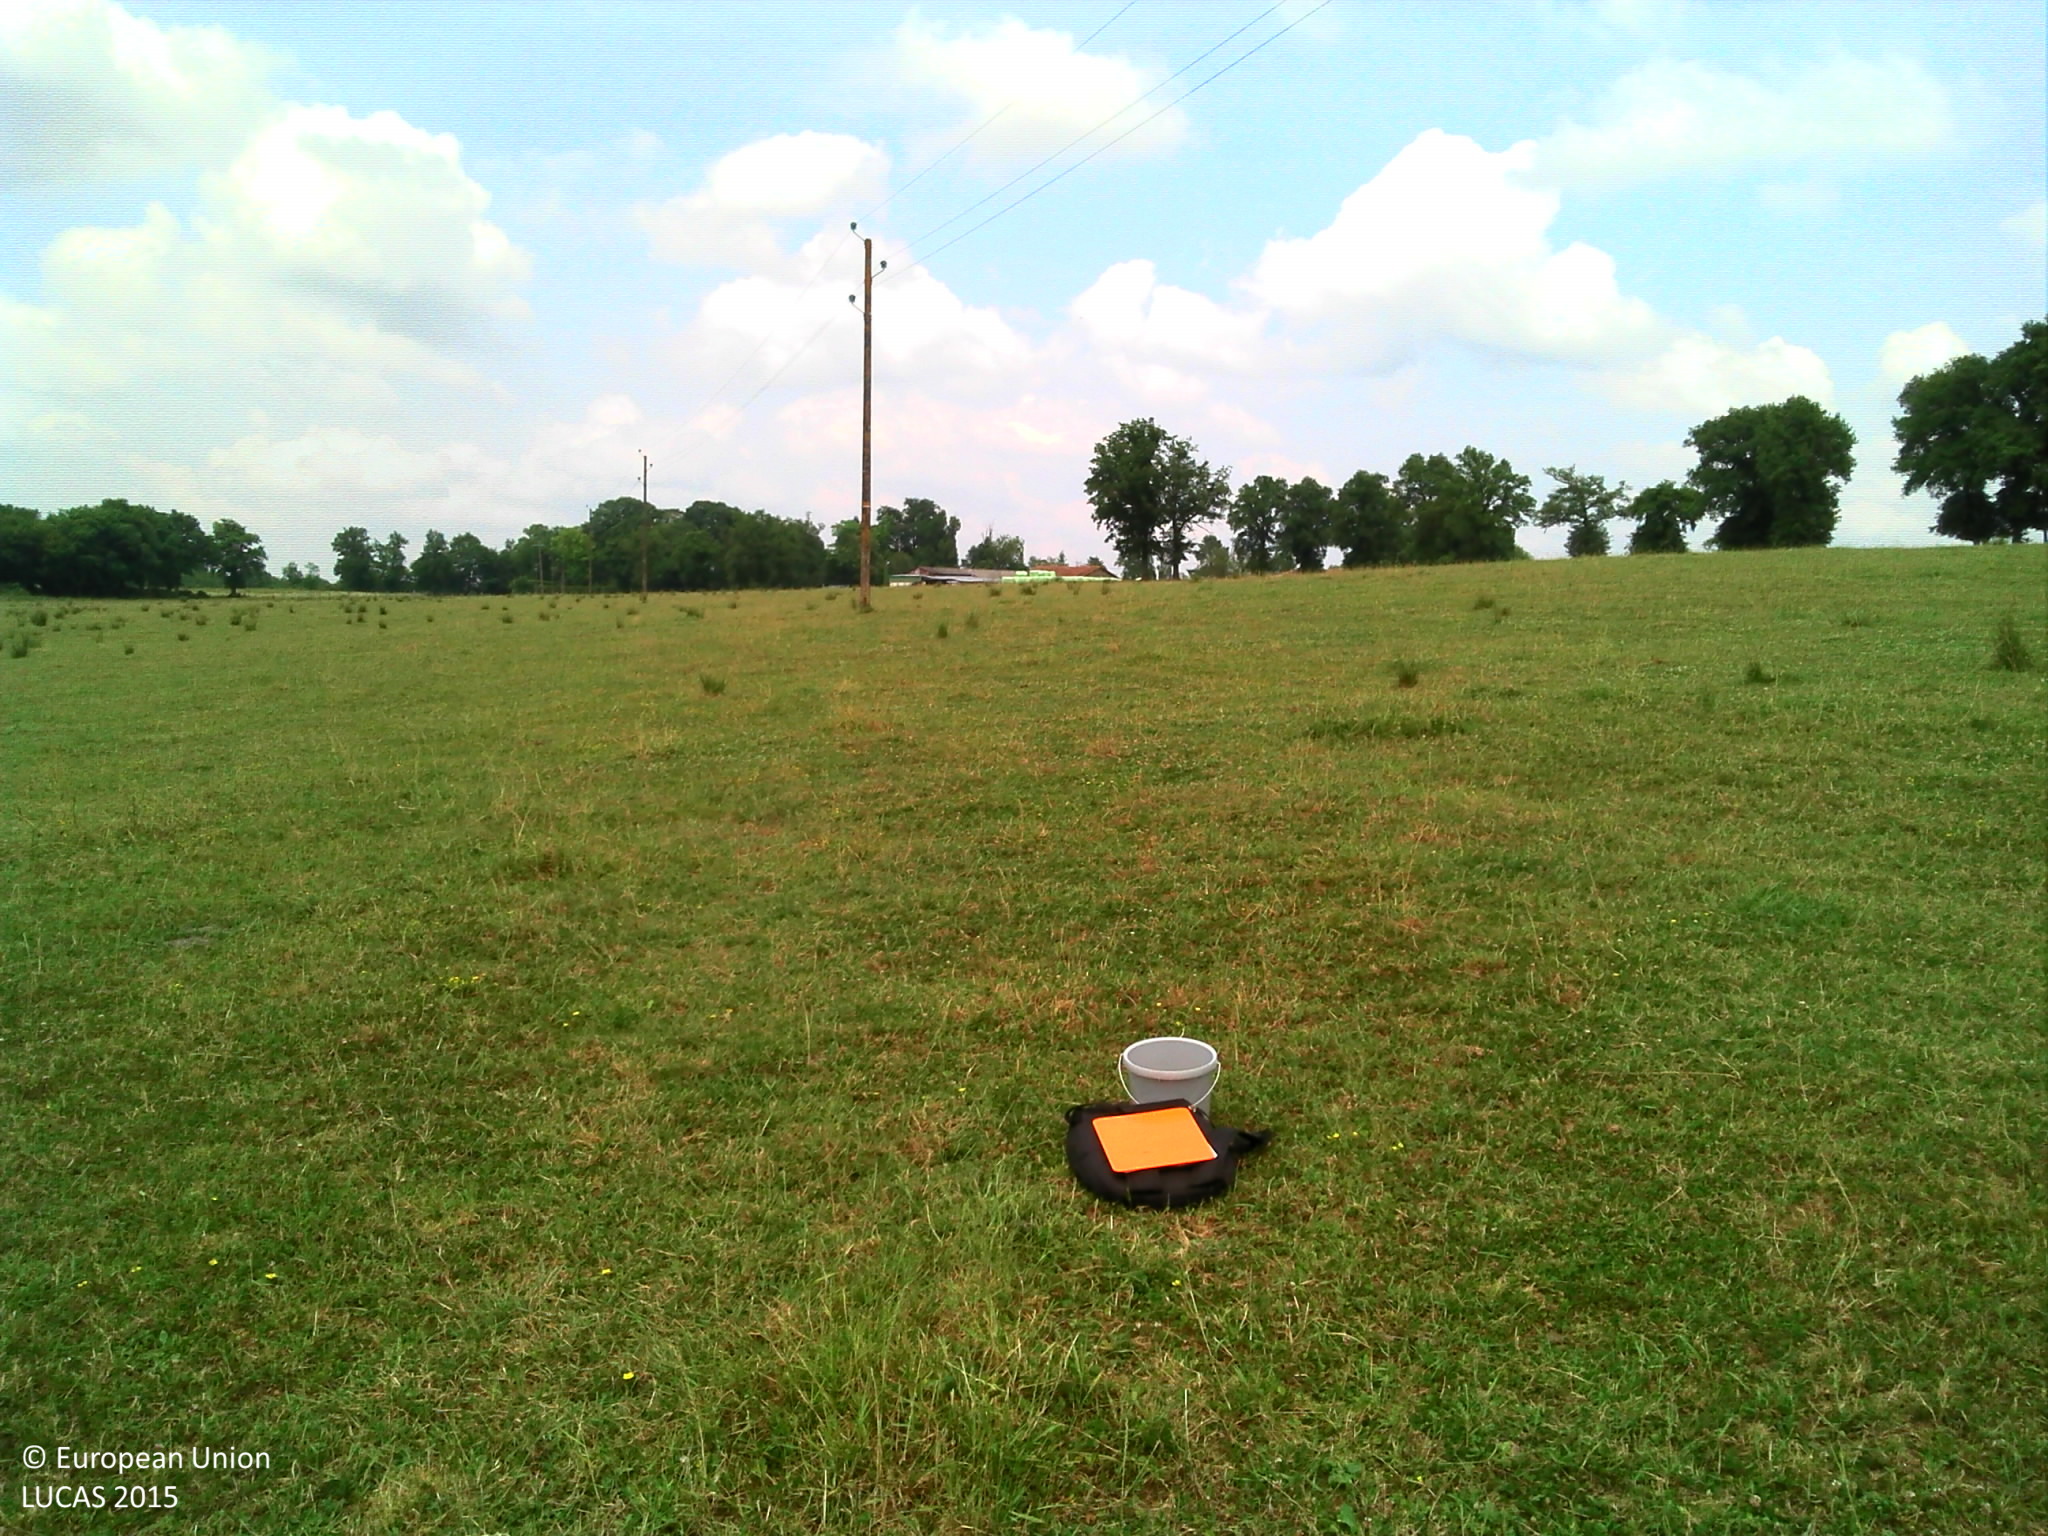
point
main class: Grassland
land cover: Grassland without tree/shrub cover
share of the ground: > 75 %
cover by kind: herbaceous plants 100 %
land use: Agriculture (excluding fallow land and kitchen gardens)
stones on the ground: < 10 %
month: June
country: FR
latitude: 46.0109
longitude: 0.6223
